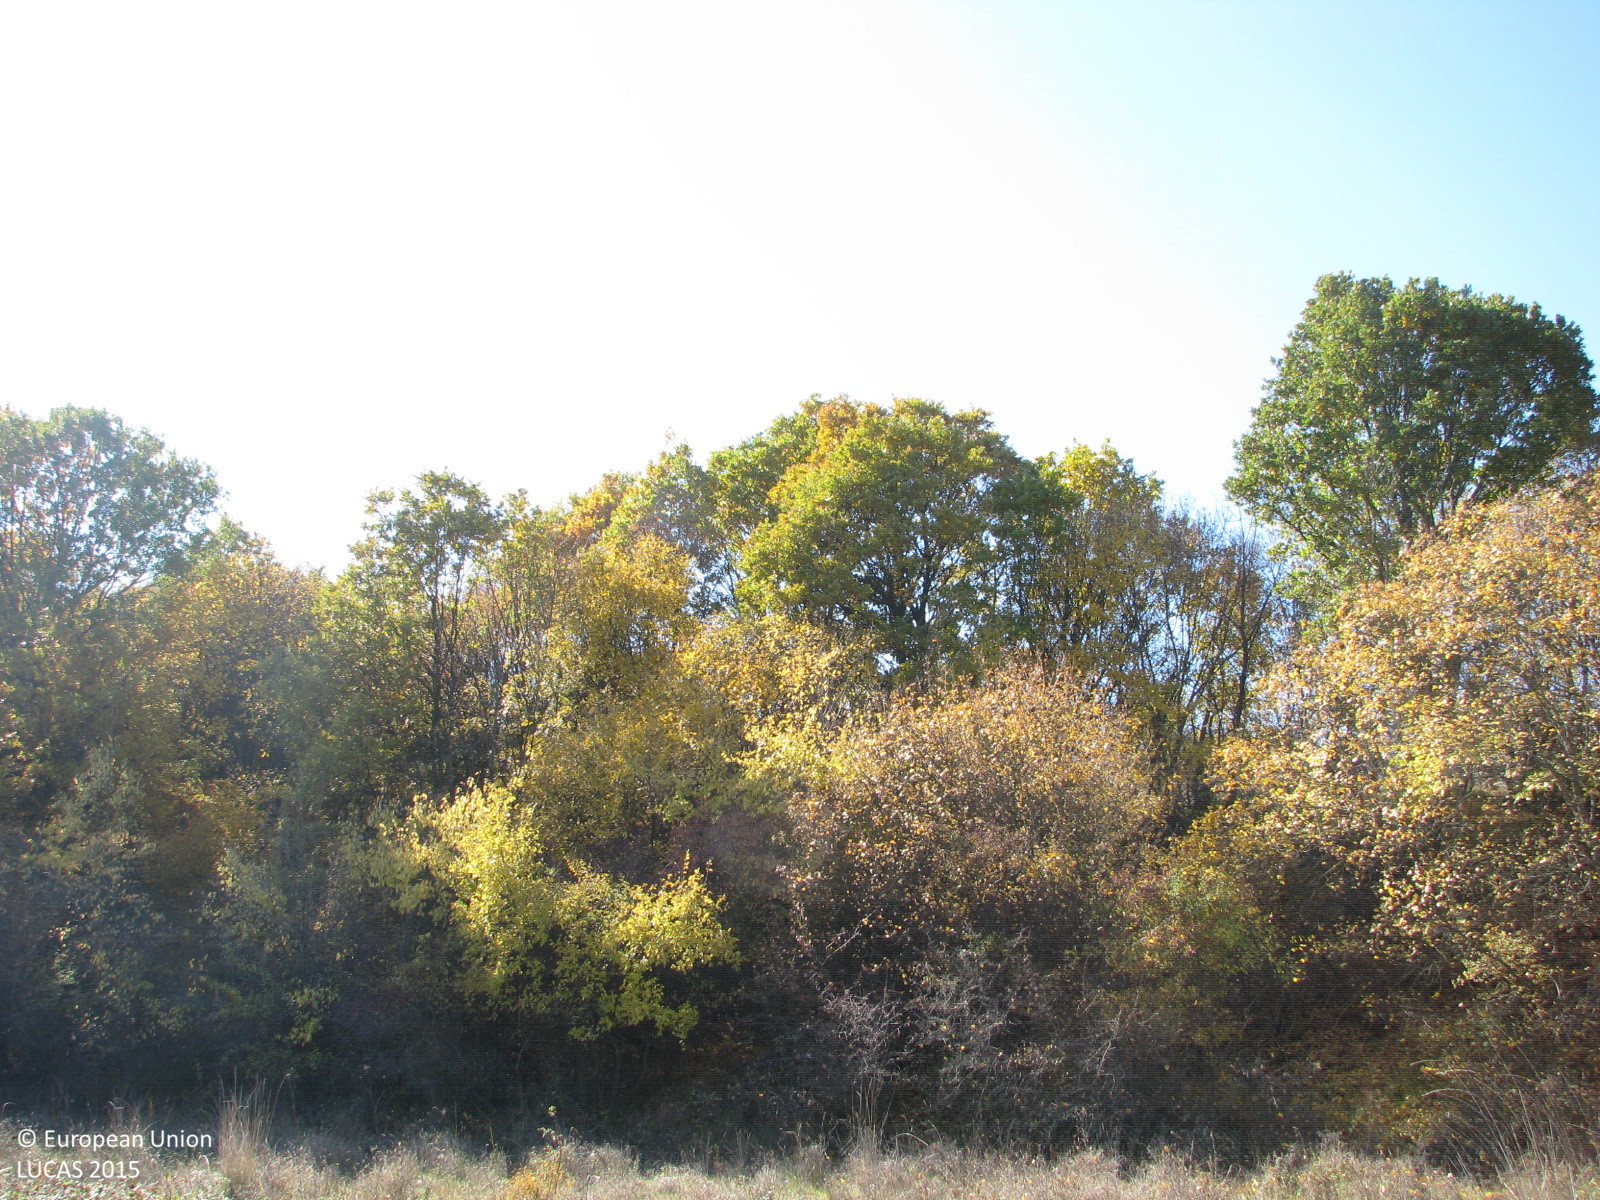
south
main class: Grassland
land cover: Grassland with sparse tree/shrub cover
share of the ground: > 75 %
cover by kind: herbaceous plants 90 %, broadleaved forest trees 5 %, shrubs 5 %
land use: Agriculture (excluding fallow land and kitchen gardens)
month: November
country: BG
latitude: 41.8968
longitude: 26.3899
